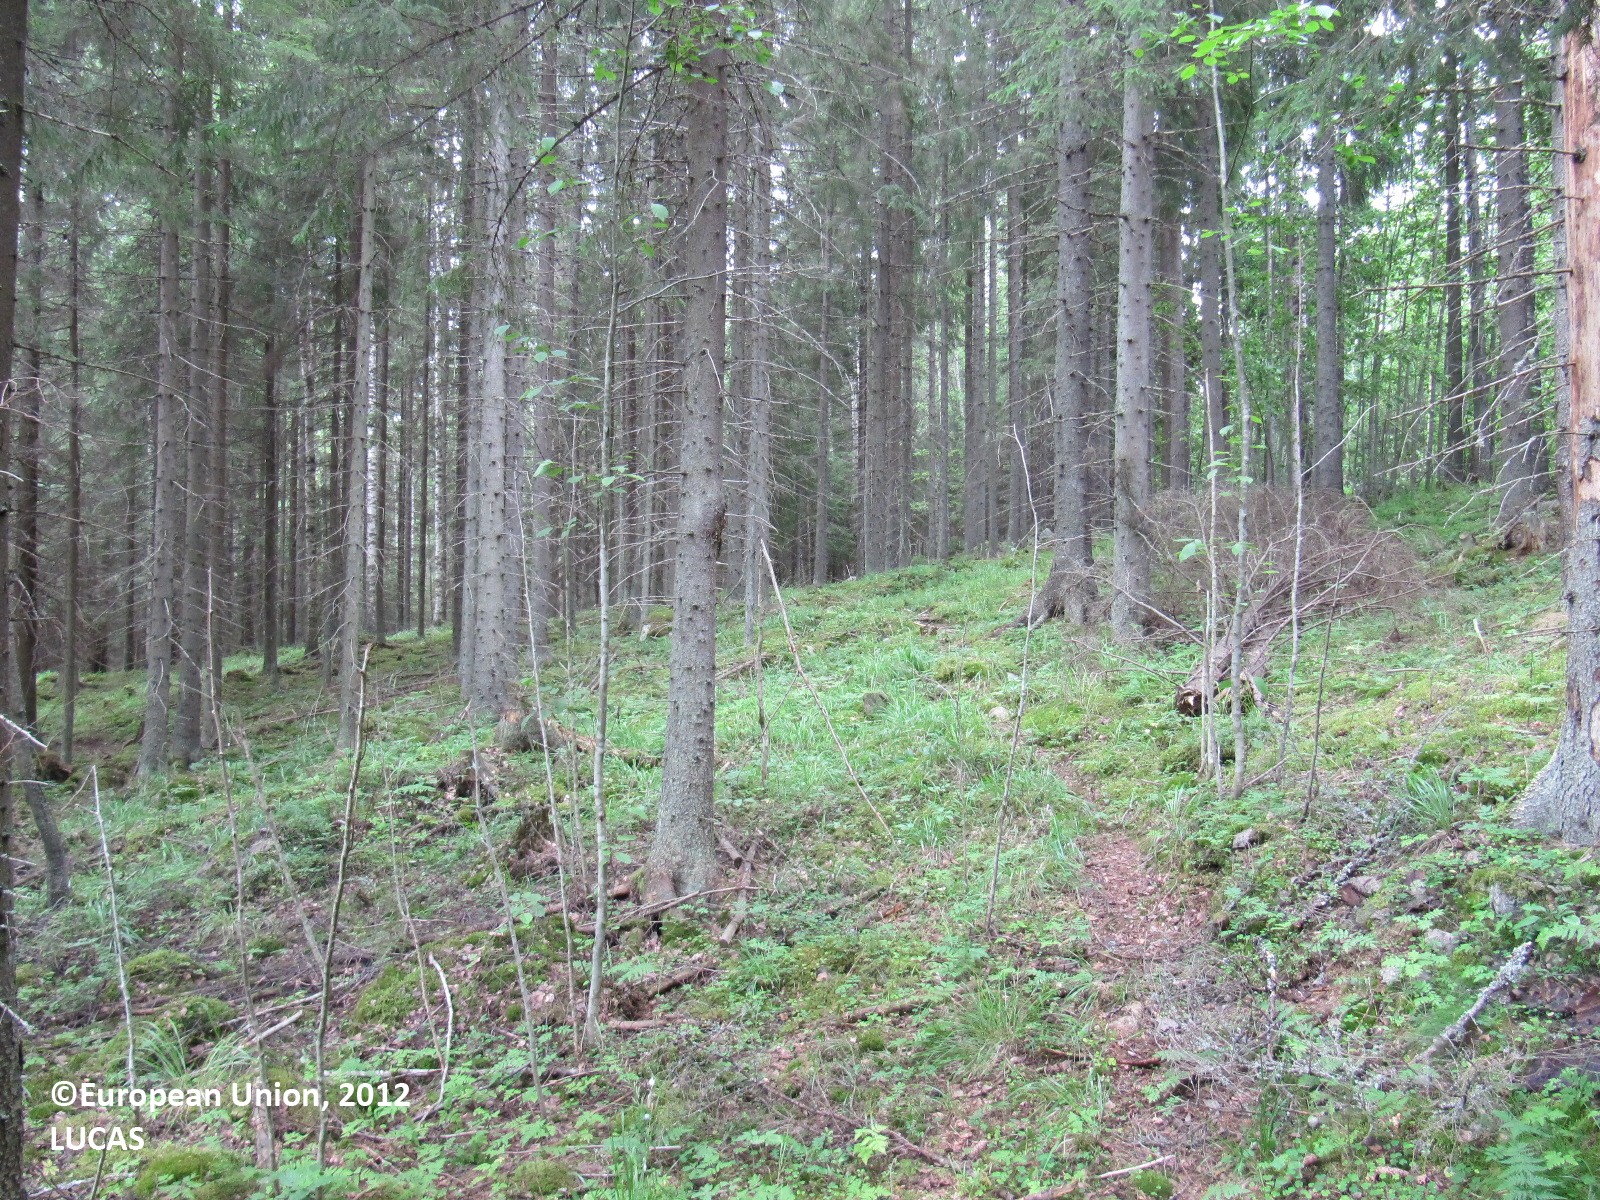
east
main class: Woodland
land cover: Spruce dominated mixed woodland
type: boreal forest
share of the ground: > 75 %
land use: Forestry
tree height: > 5 m
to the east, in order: Spruce dominated mixed woodland
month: July
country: FI
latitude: 60.8309
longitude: 24.5810
